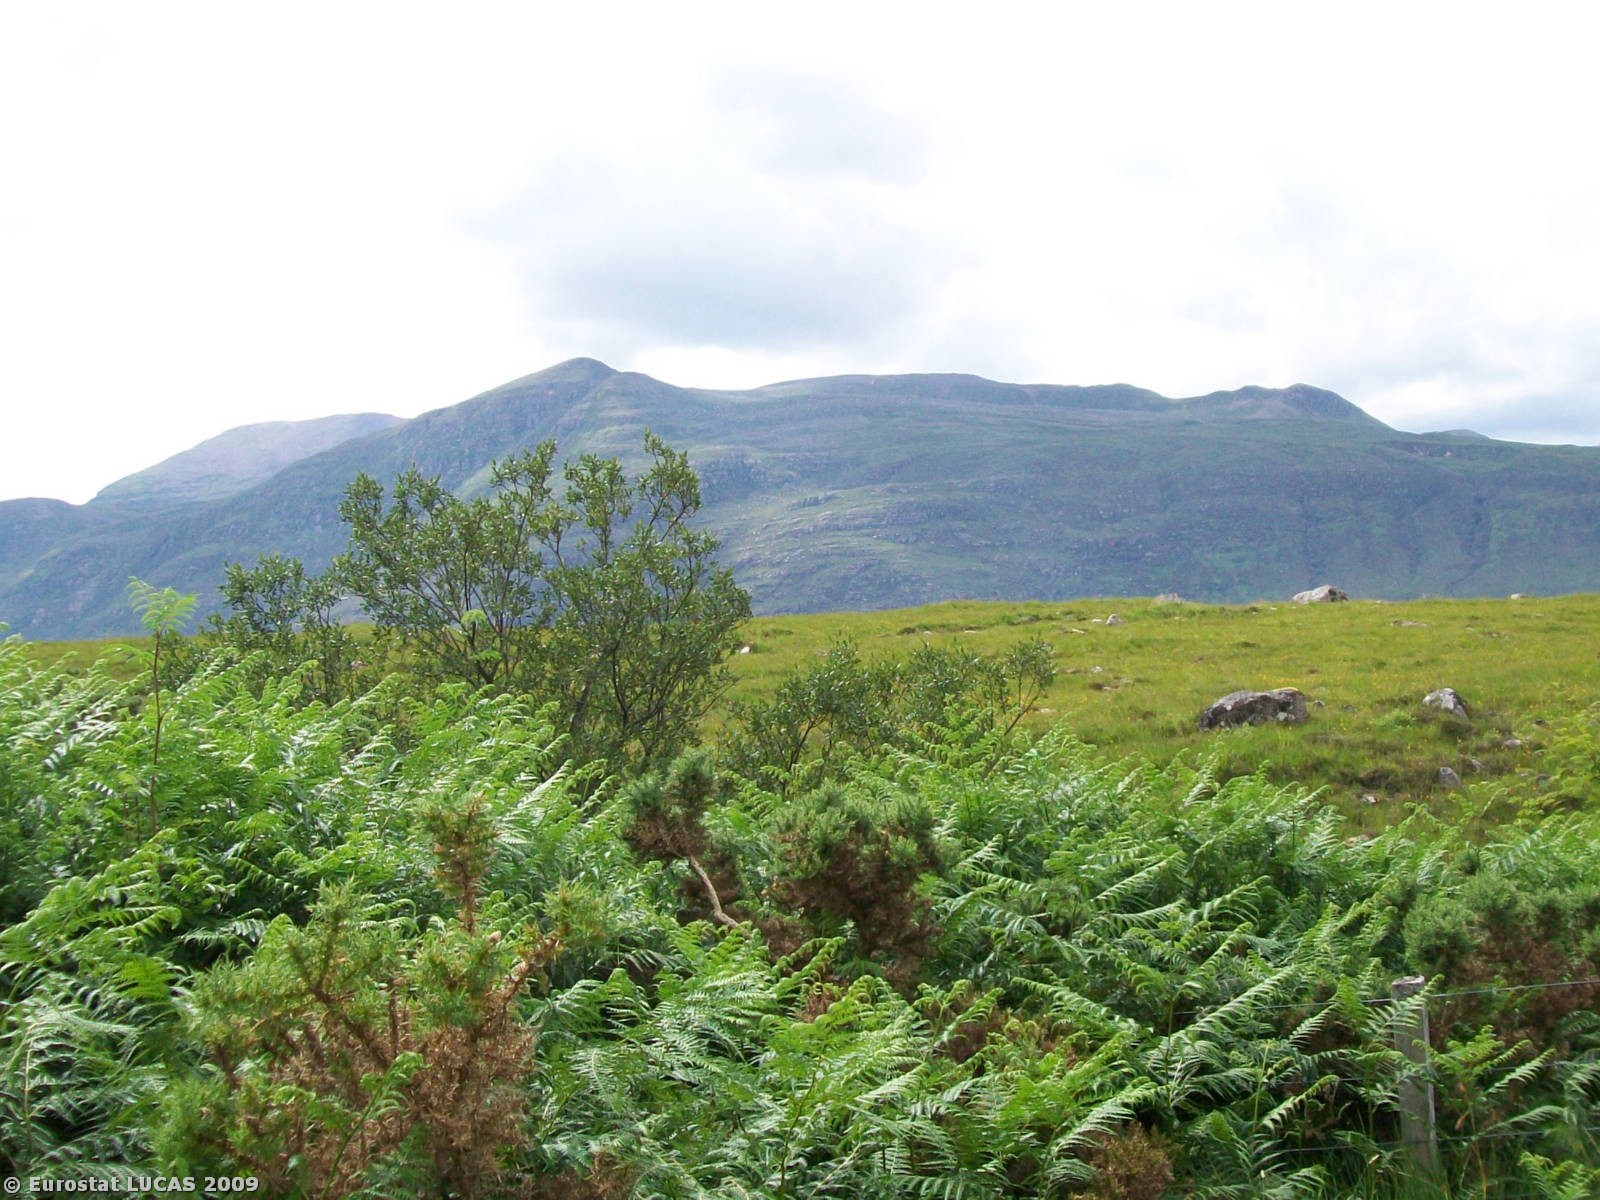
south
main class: Shrubland
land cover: Shrubland without tree cover
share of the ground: > 75 %
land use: Holiday camps
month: July
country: GB
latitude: 57.8724
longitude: -5.2634
